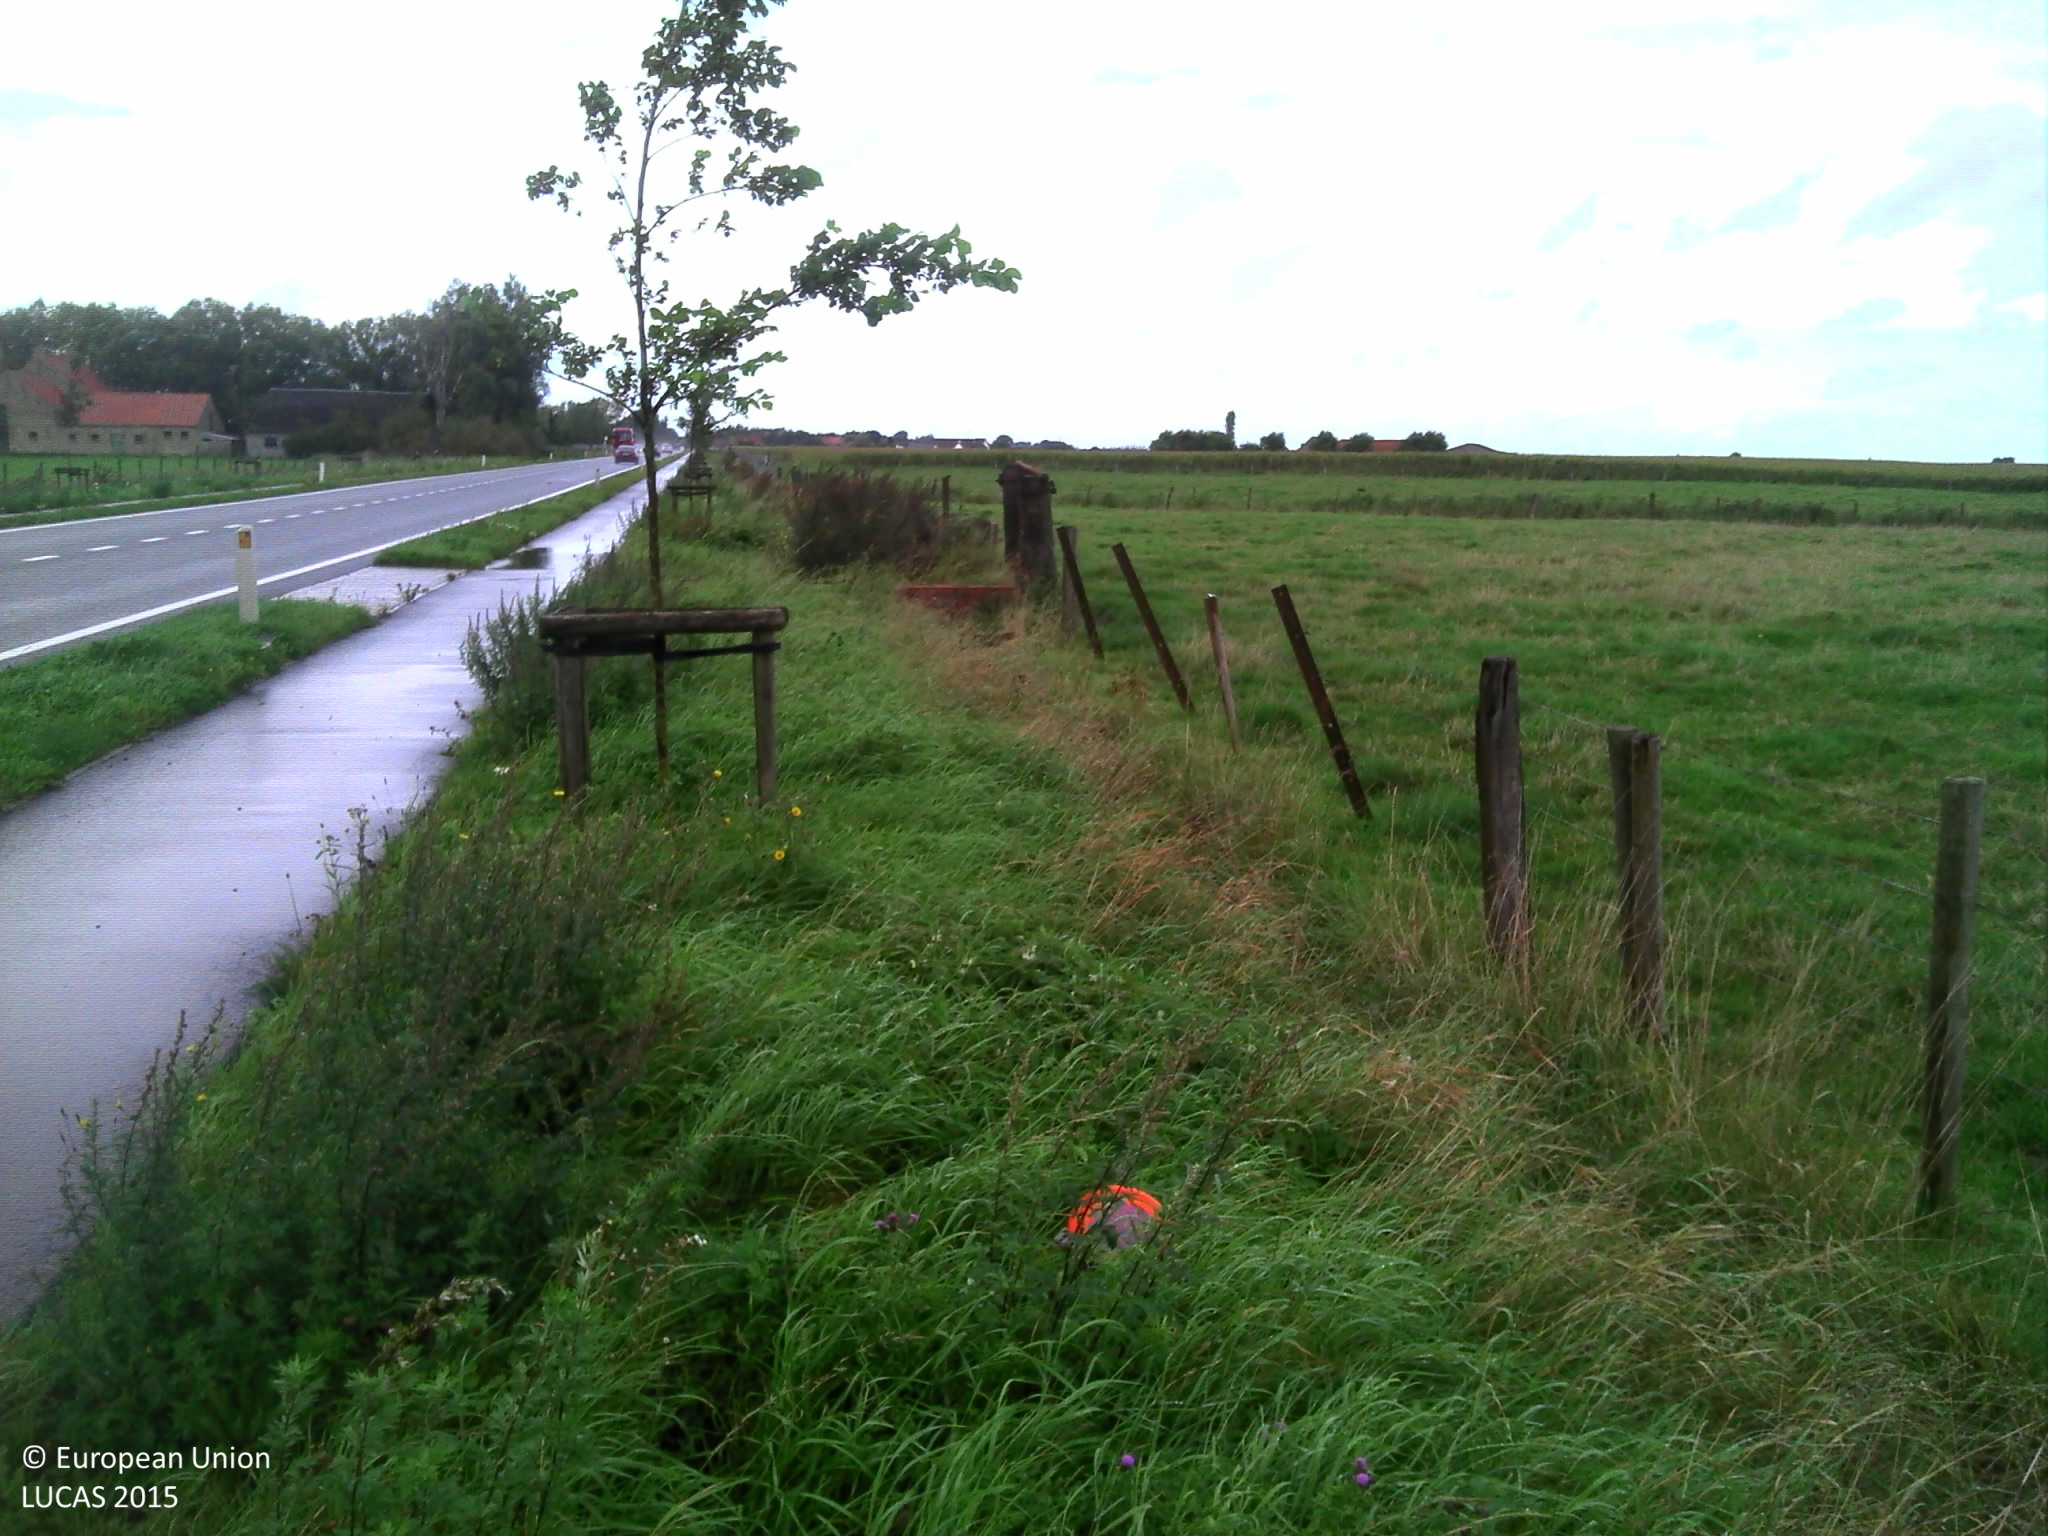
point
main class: Grassland
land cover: Grassland without tree/shrub cover
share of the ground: > 75 %
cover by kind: herbaceous plants 100 %
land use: Agriculture (excluding fallow land and kitchen gardens)
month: September
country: BE
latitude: 51.1174
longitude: 2.8892
